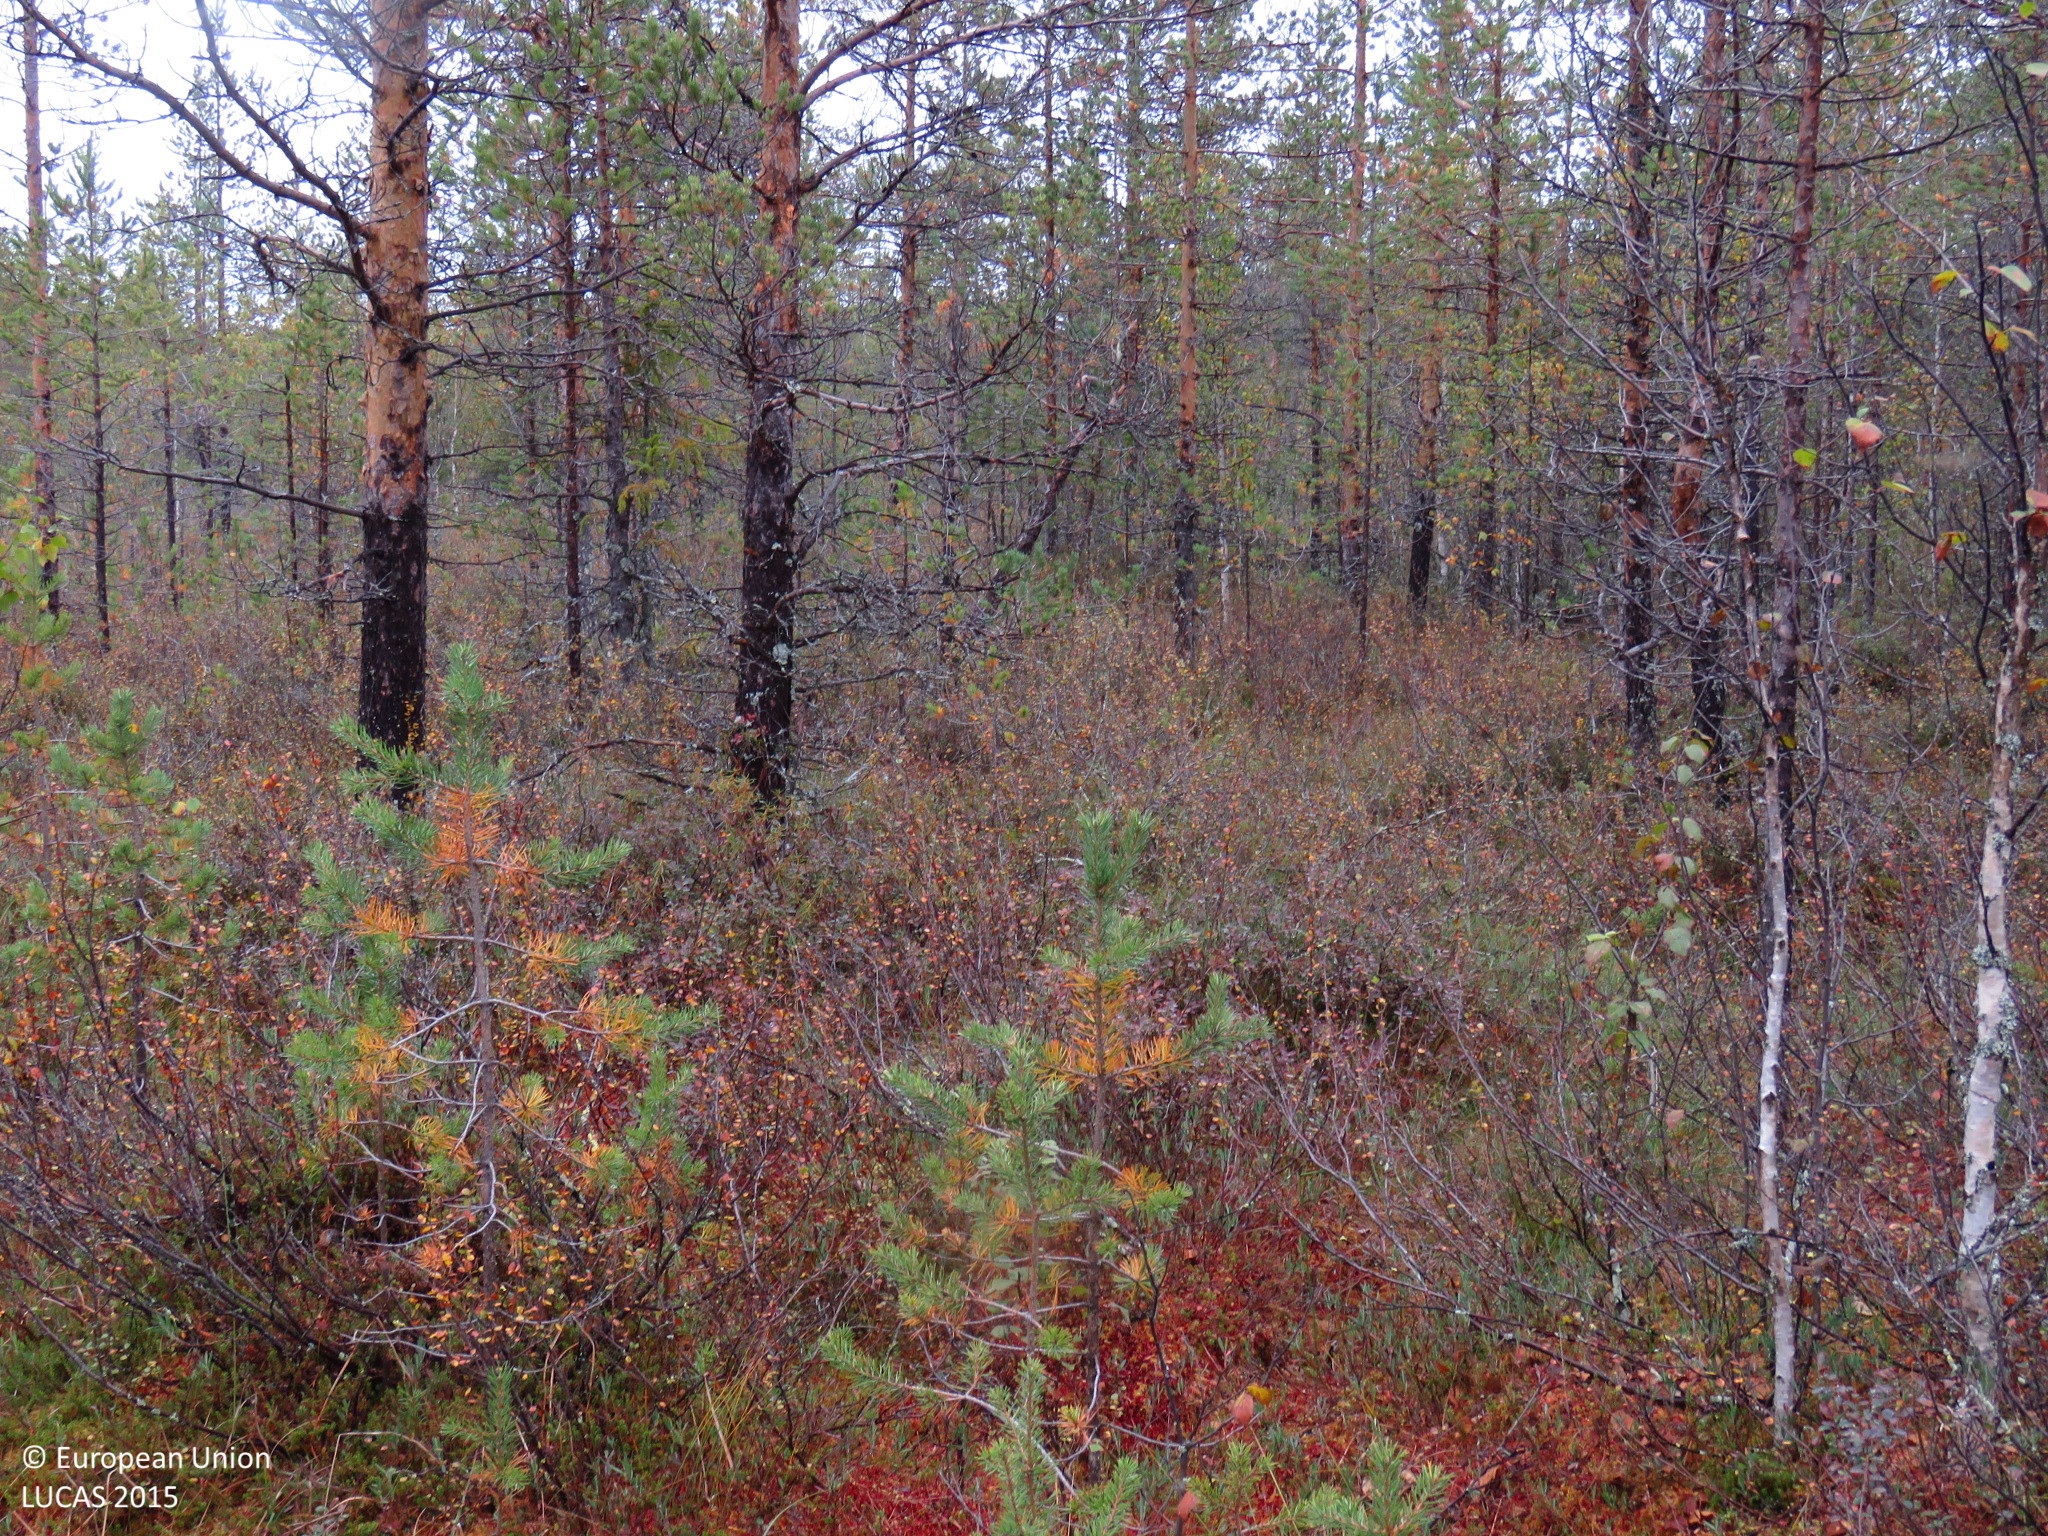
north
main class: Woodland
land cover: Pine dominated coniferous woodland
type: mire and swamp forests
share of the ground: > 75 %
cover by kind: coniferous forest trees 60 %, broadleaved forest trees 15 %, shrubs 15 %, herbaceous plants 5 %, lichens and mosses 5 %
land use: Forestry
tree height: > 5 m
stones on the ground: < 10 %
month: September
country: FI
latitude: 65.2788
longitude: 27.4685
